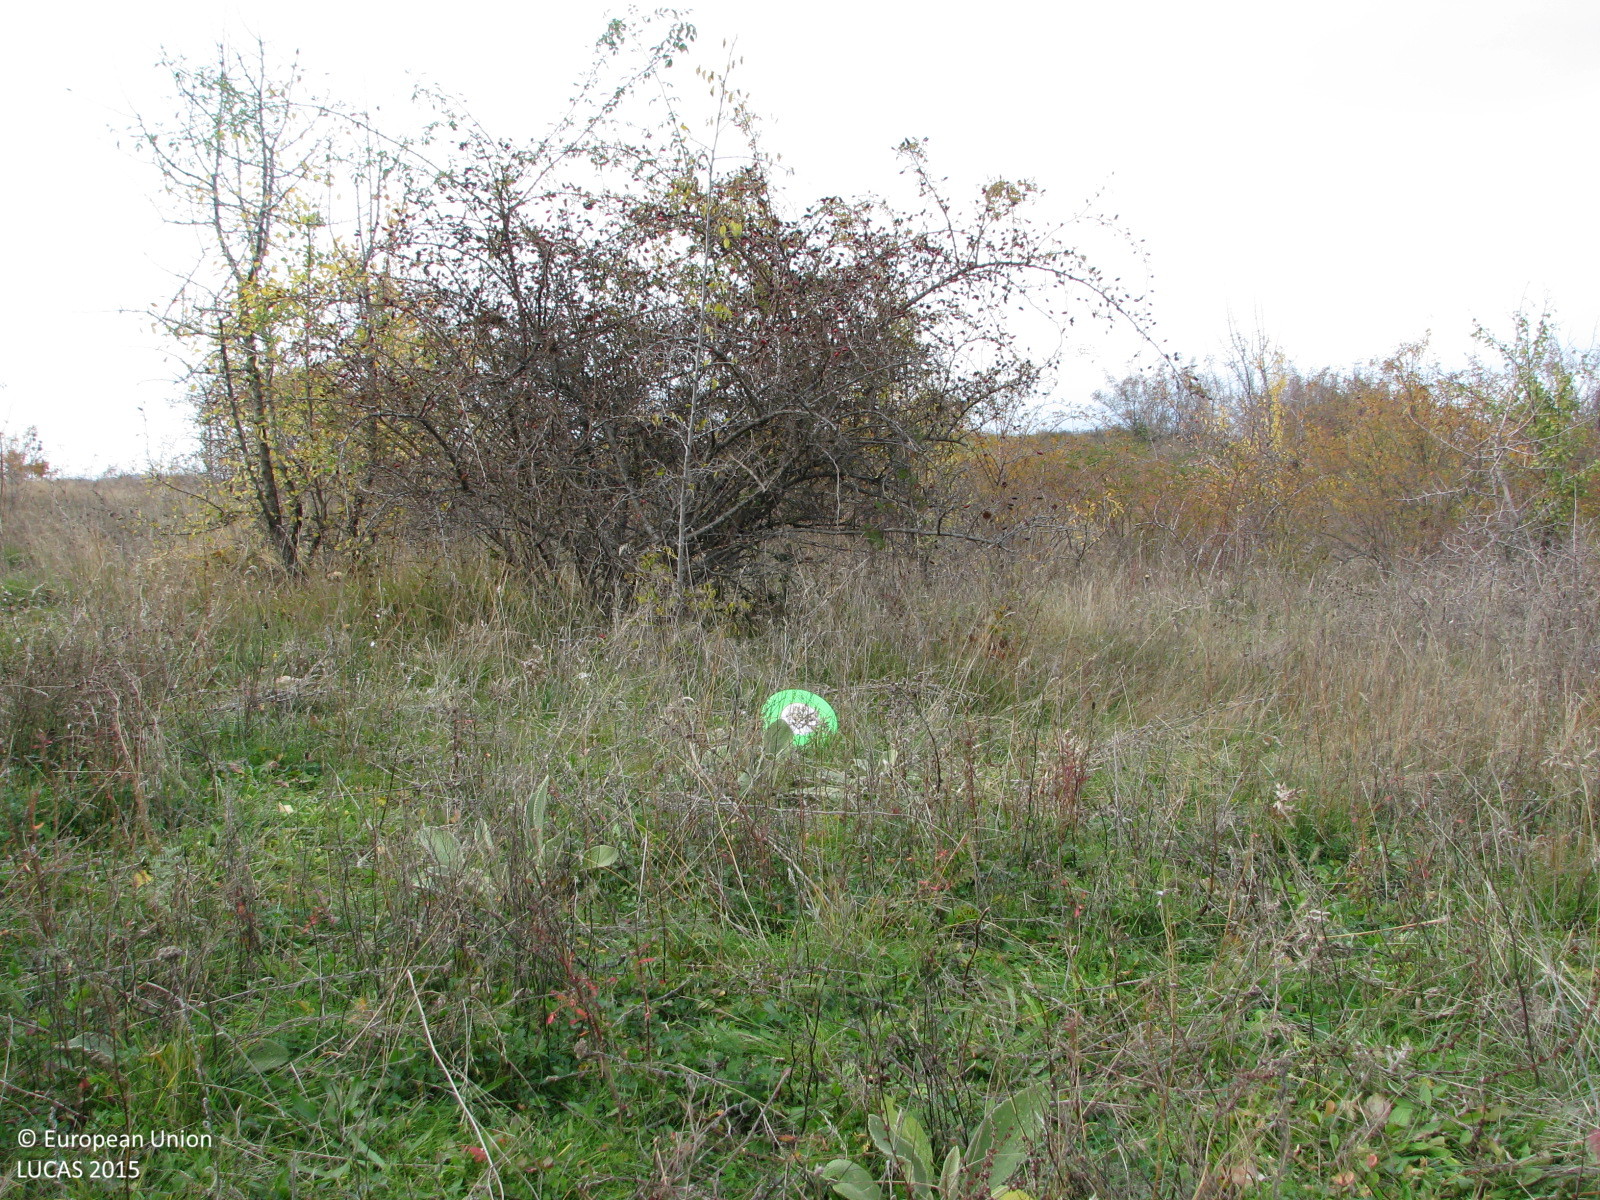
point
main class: Grassland
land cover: Grassland with sparse tree/shrub cover
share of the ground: > 75 %
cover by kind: herbaceous plants 85 %, shrubs 10 %, broadleaved forest trees 5 %
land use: Agriculture (excluding fallow land and kitchen gardens)
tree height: < 5 m
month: November
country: BG
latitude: 41.9710
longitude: 26.3856
